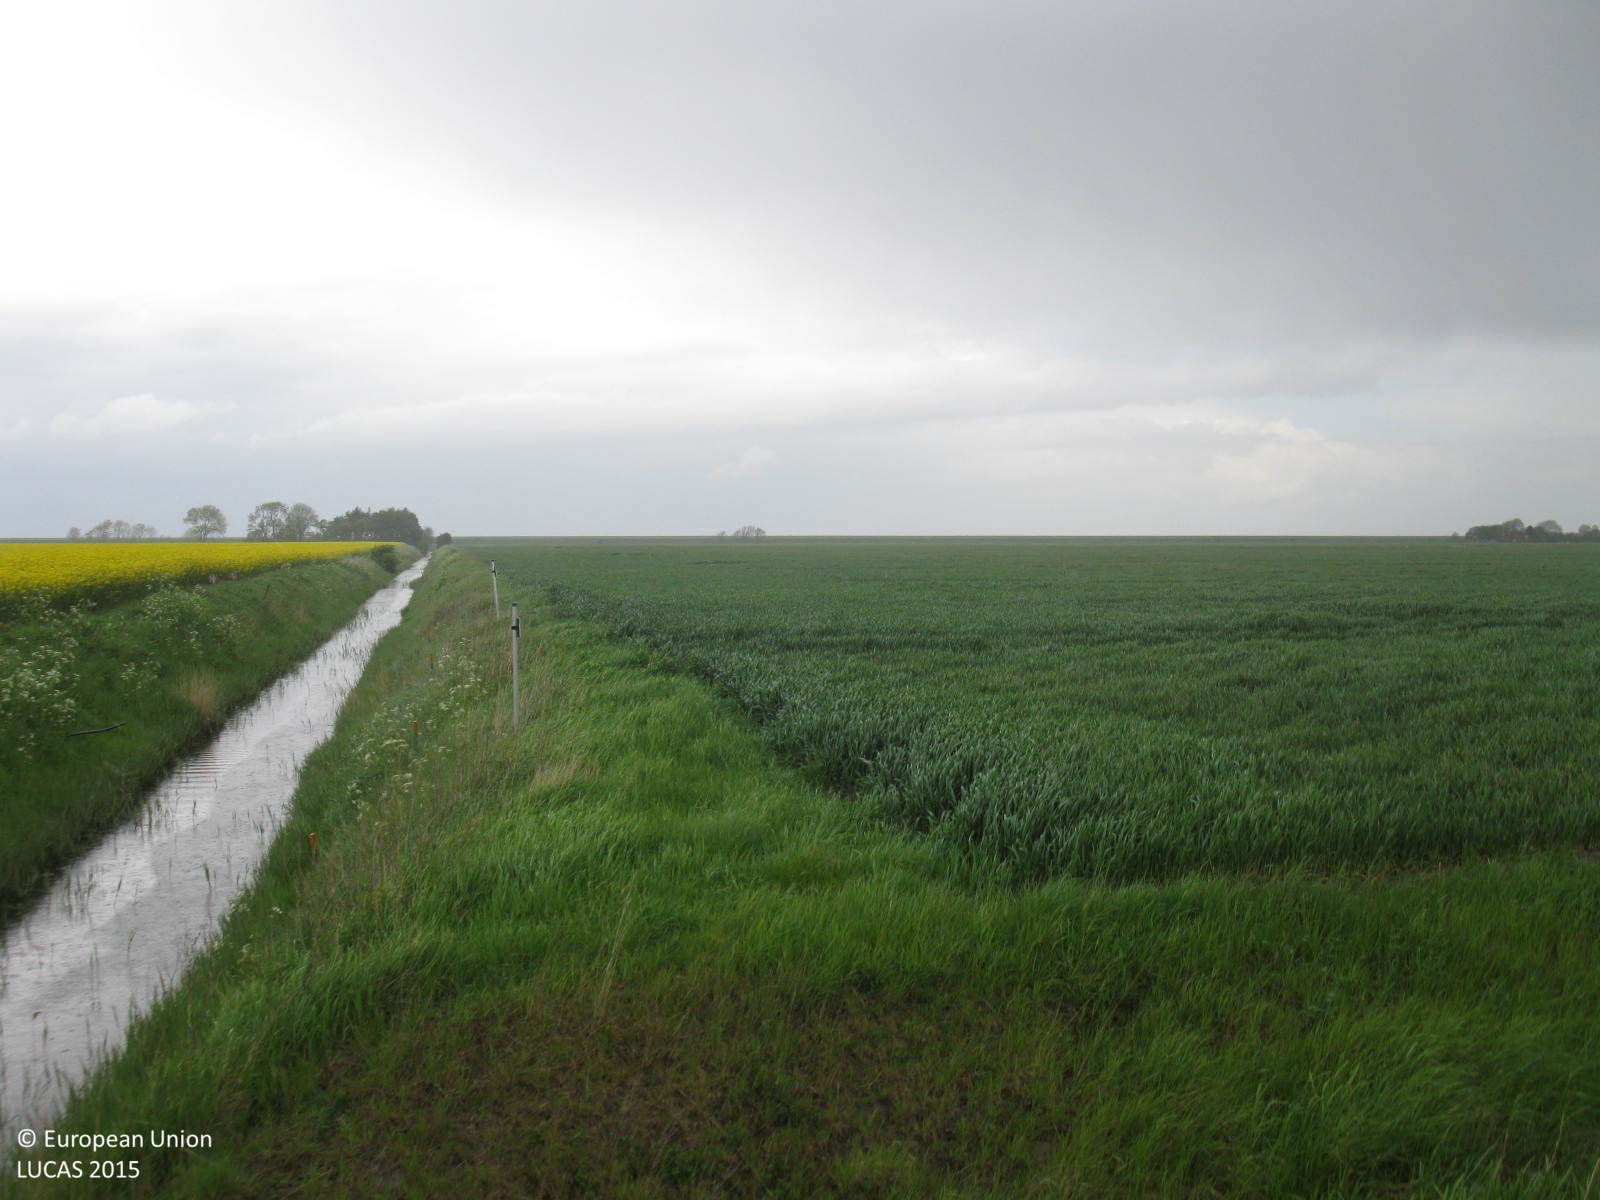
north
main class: Cropland
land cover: Rape and turnip rape
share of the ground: > 75 %
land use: Agriculture (excluding fallow land and kitchen gardens)
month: May
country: DE
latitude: 53.6587
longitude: 7.2618
